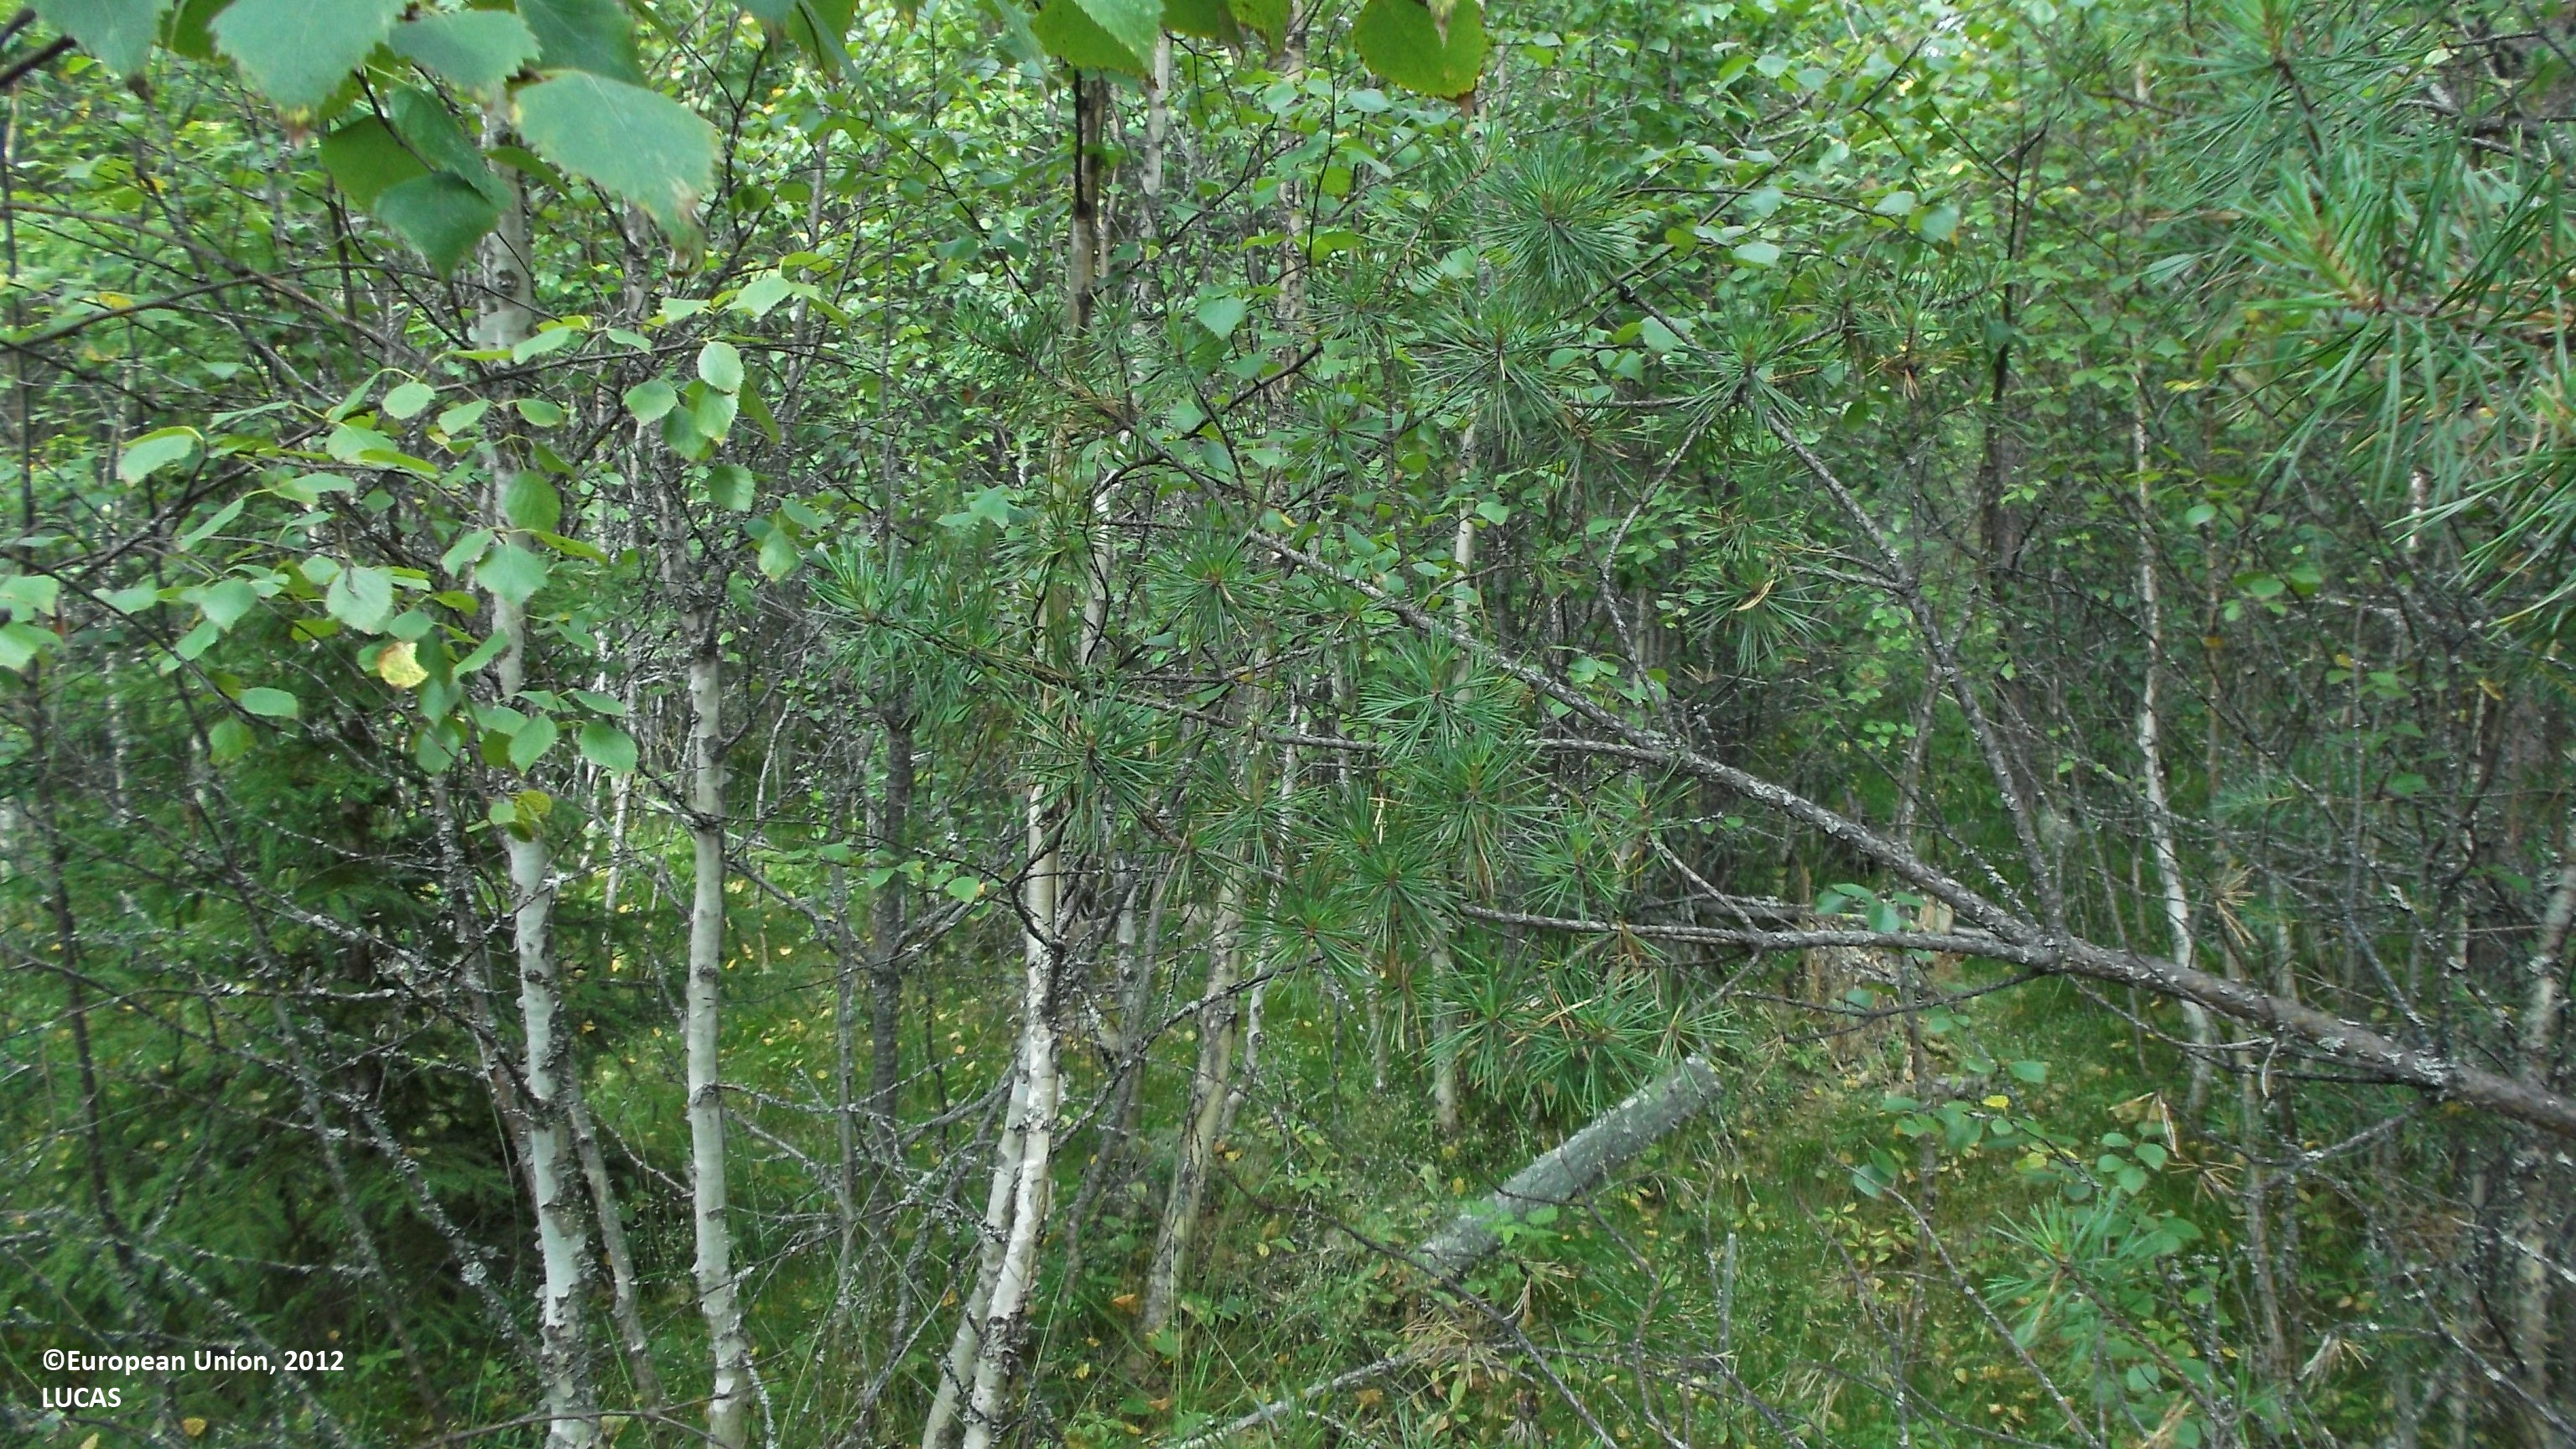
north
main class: Woodland
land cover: Other mixed woodland
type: boreal forest
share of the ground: 50 - 75 %
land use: Forestry
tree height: > 5 m
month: July
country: FI
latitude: 63.6638
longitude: 23.3725
